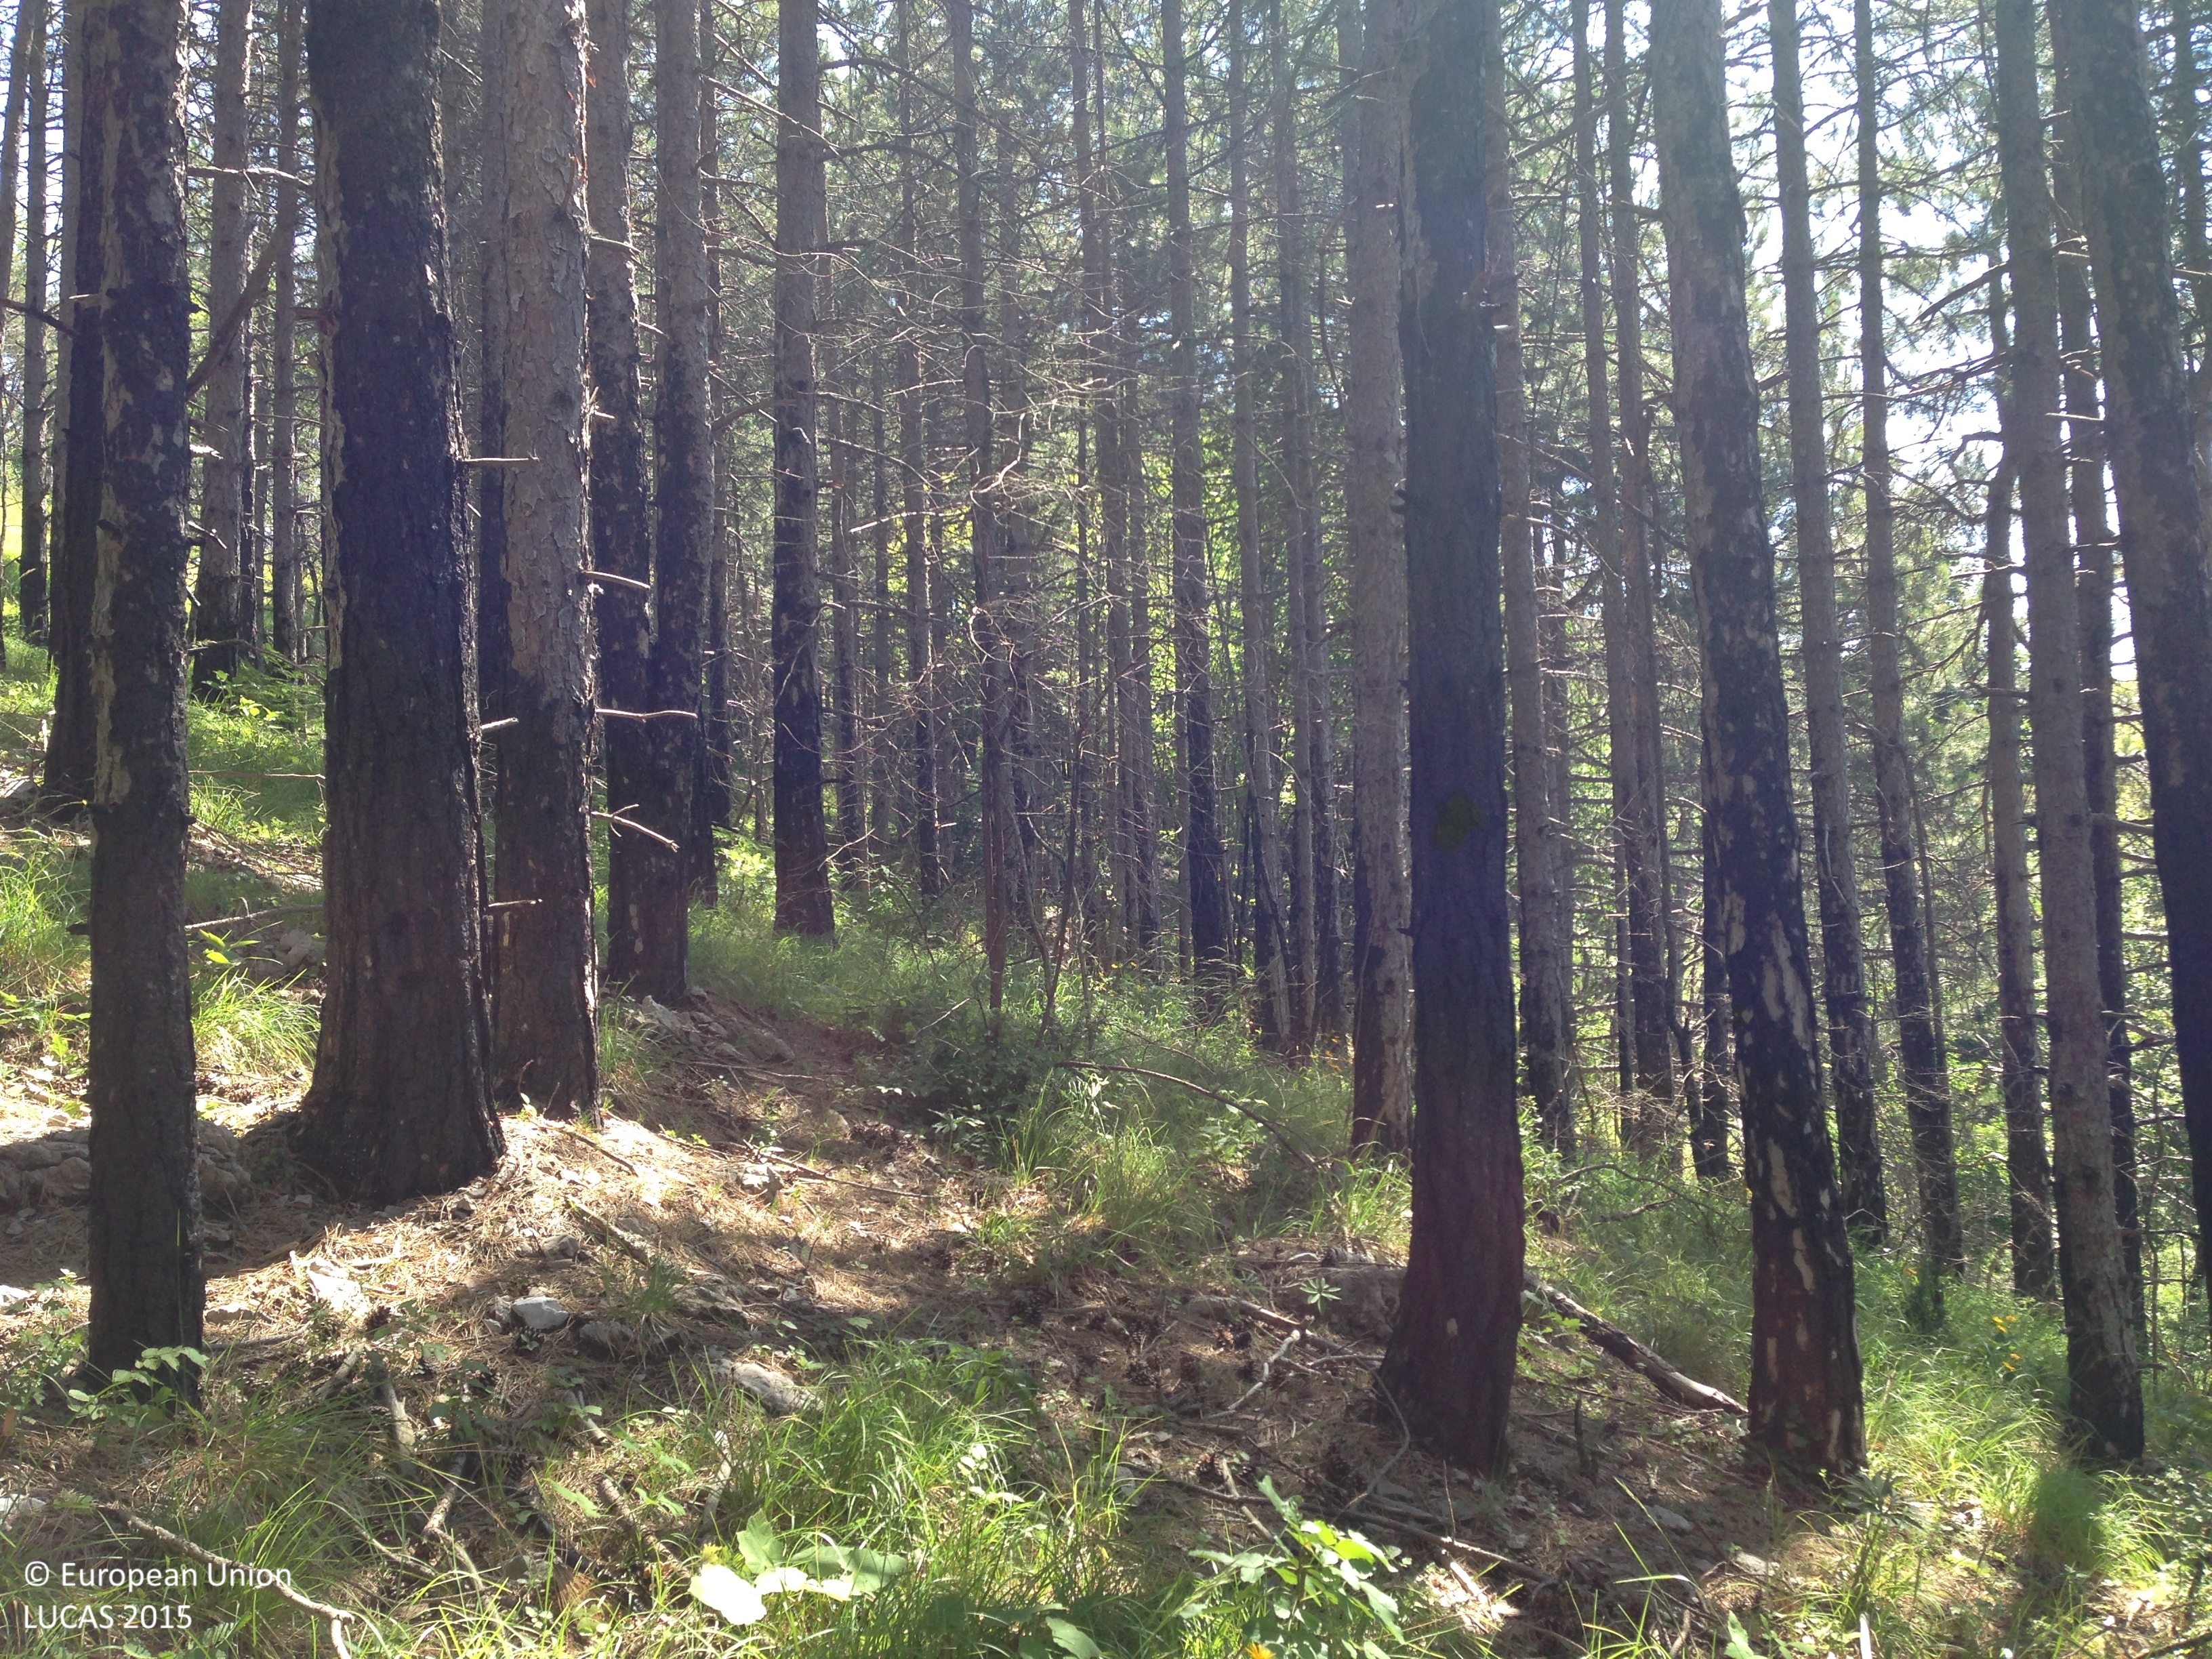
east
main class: Woodland
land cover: Pine dominated coniferous woodland
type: coniferous forest of the mediterranean region
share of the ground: > 75 %
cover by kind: coniferous forest trees 45 %, herbaceous plants 20 %, broadleaved forest trees 15 %, shrubs 5 %, lichens and mosses 5 %, consolidated bare surface 5 %, unconsolidated bare surface 5 %
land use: Forestry
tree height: > 5 m
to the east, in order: Pine dominated coniferous woodland; Tracks; Pine dominated coniferous woodland
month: July
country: HR
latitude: 44.6742
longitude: 15.1530
